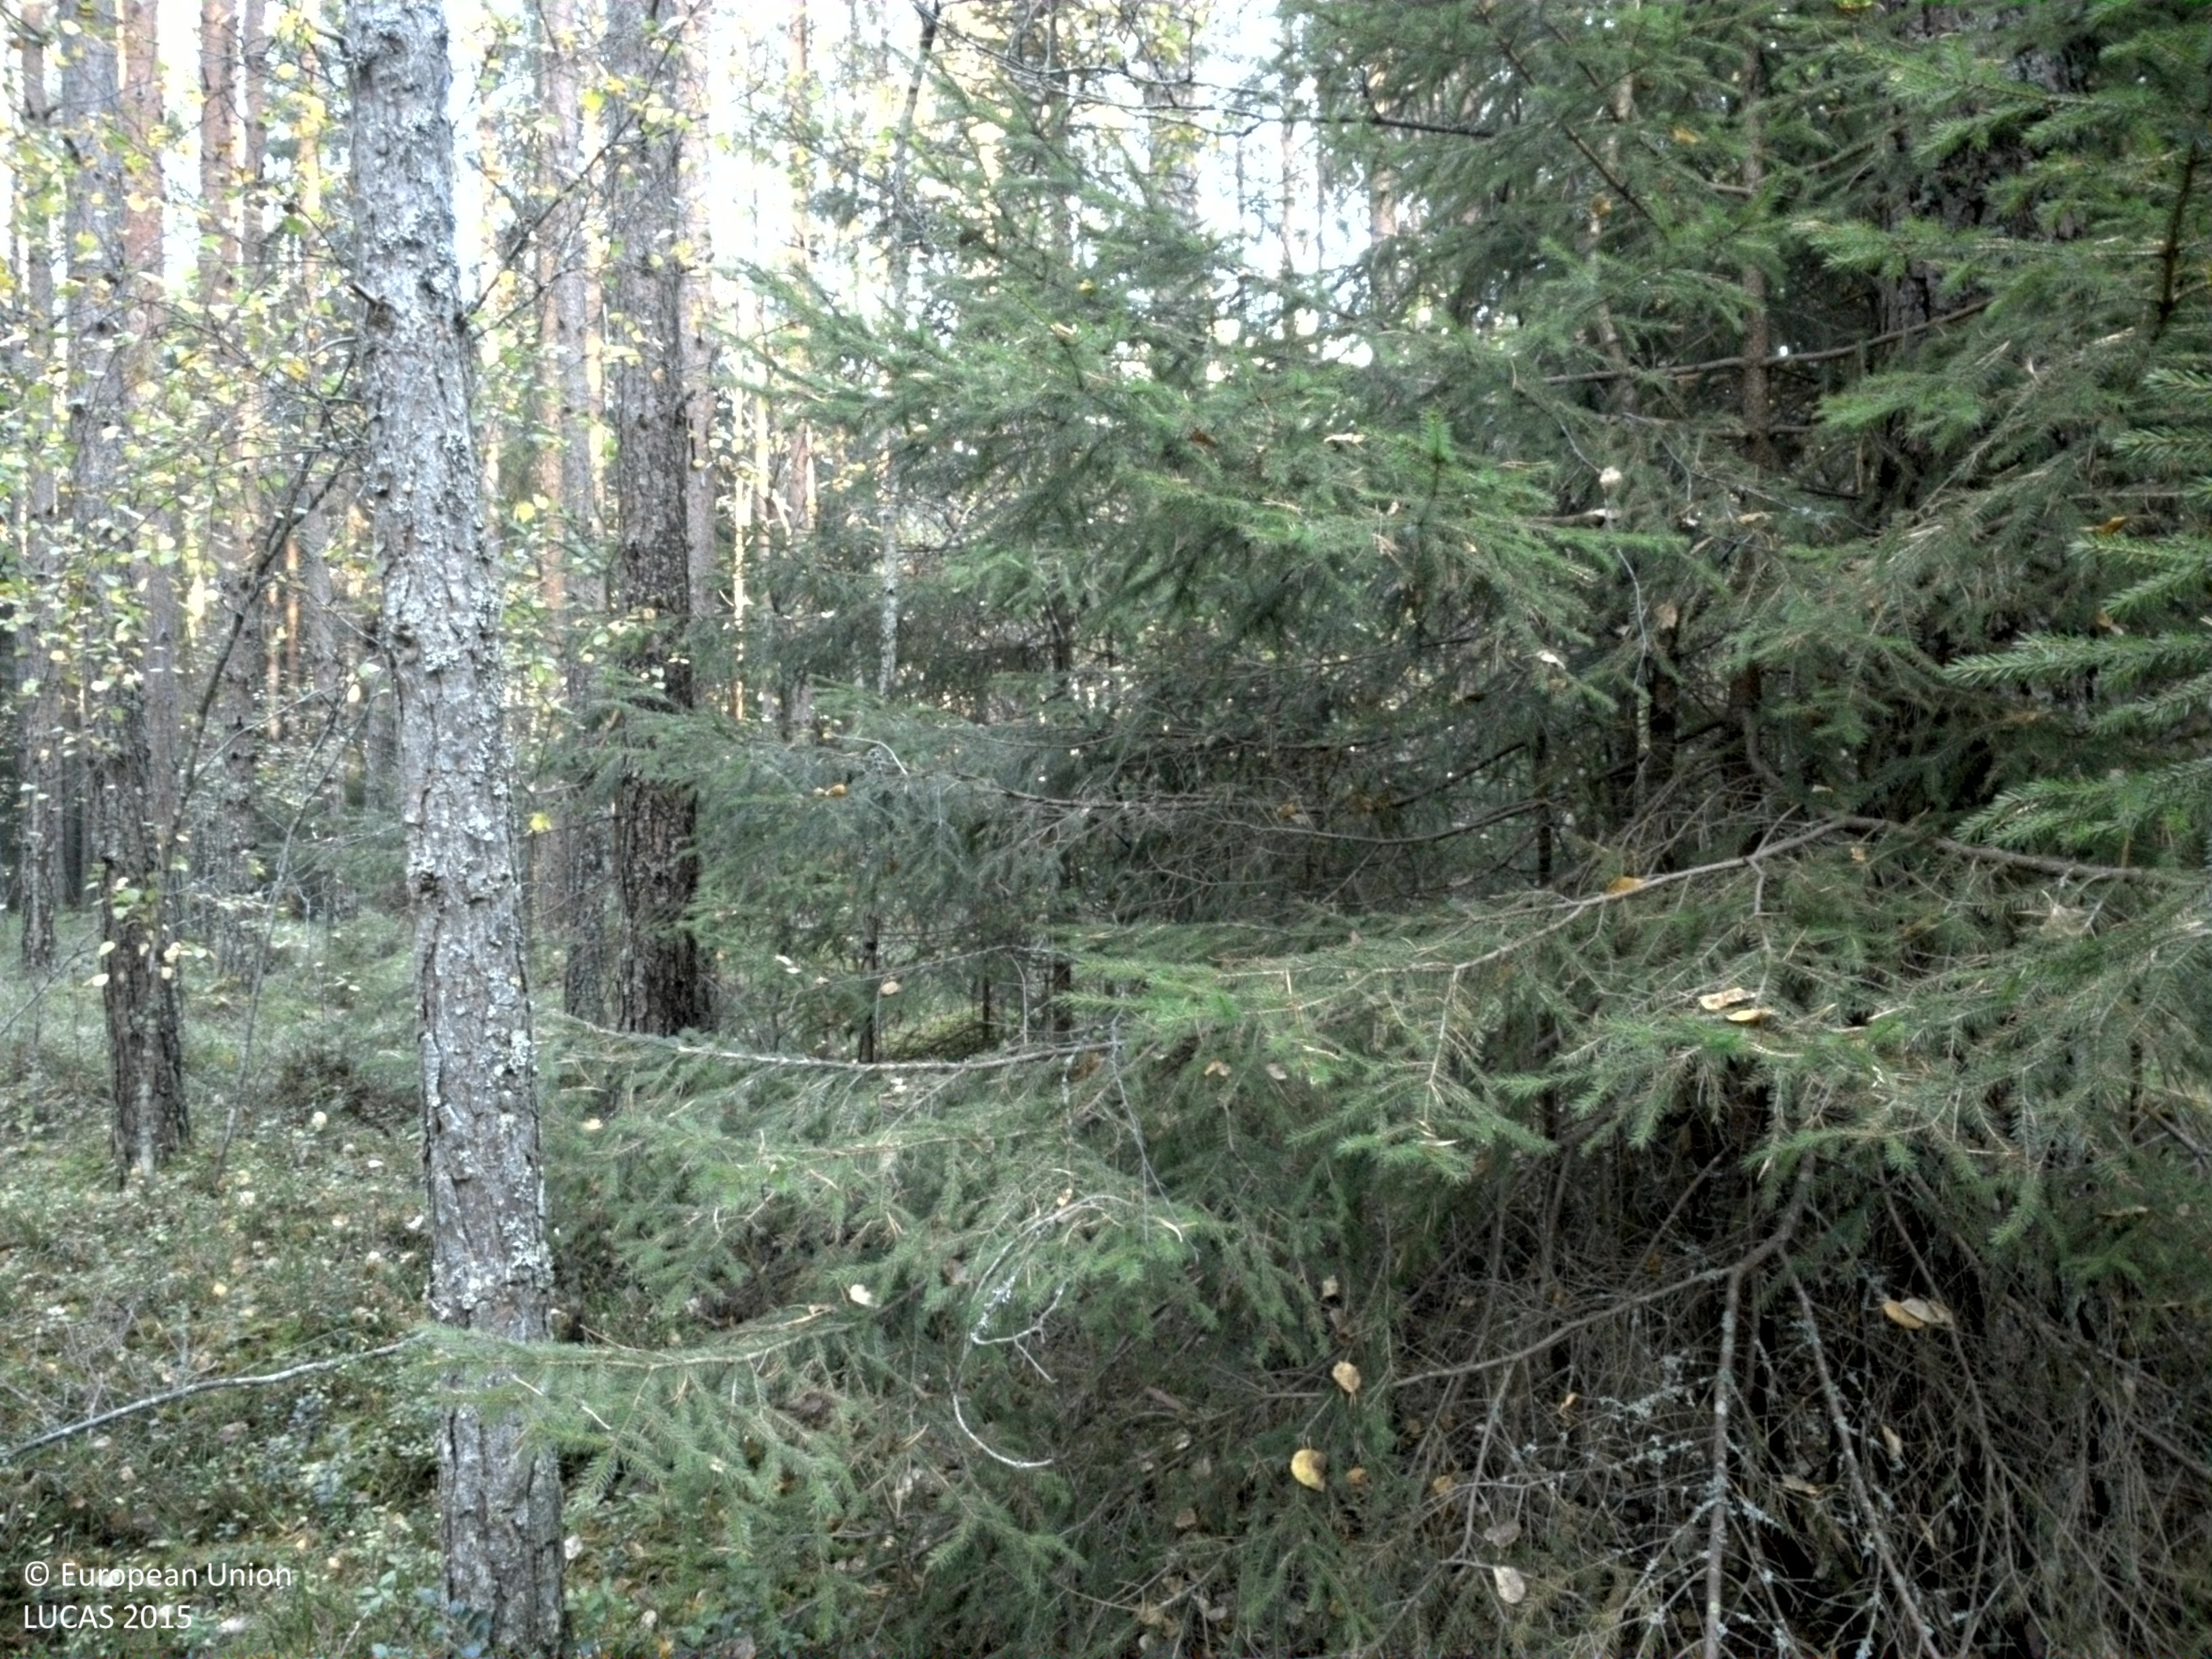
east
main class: Woodland
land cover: Pine dominated coniferous woodland
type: boreal forest
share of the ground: > 75 %
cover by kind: coniferous forest trees 70 %, broadleaved forest trees 15 %, lichens and mosses 15 %
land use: Forestry
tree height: > 5 m
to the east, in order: Pine dominated coniferous woodland; Shrubland with sparse tree cover; Electric lines; Broadleaved woodland; Pine dominated coniferous woodland; Other coniferous woodland
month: September
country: SE
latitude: 59.9931
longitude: 16.5338
